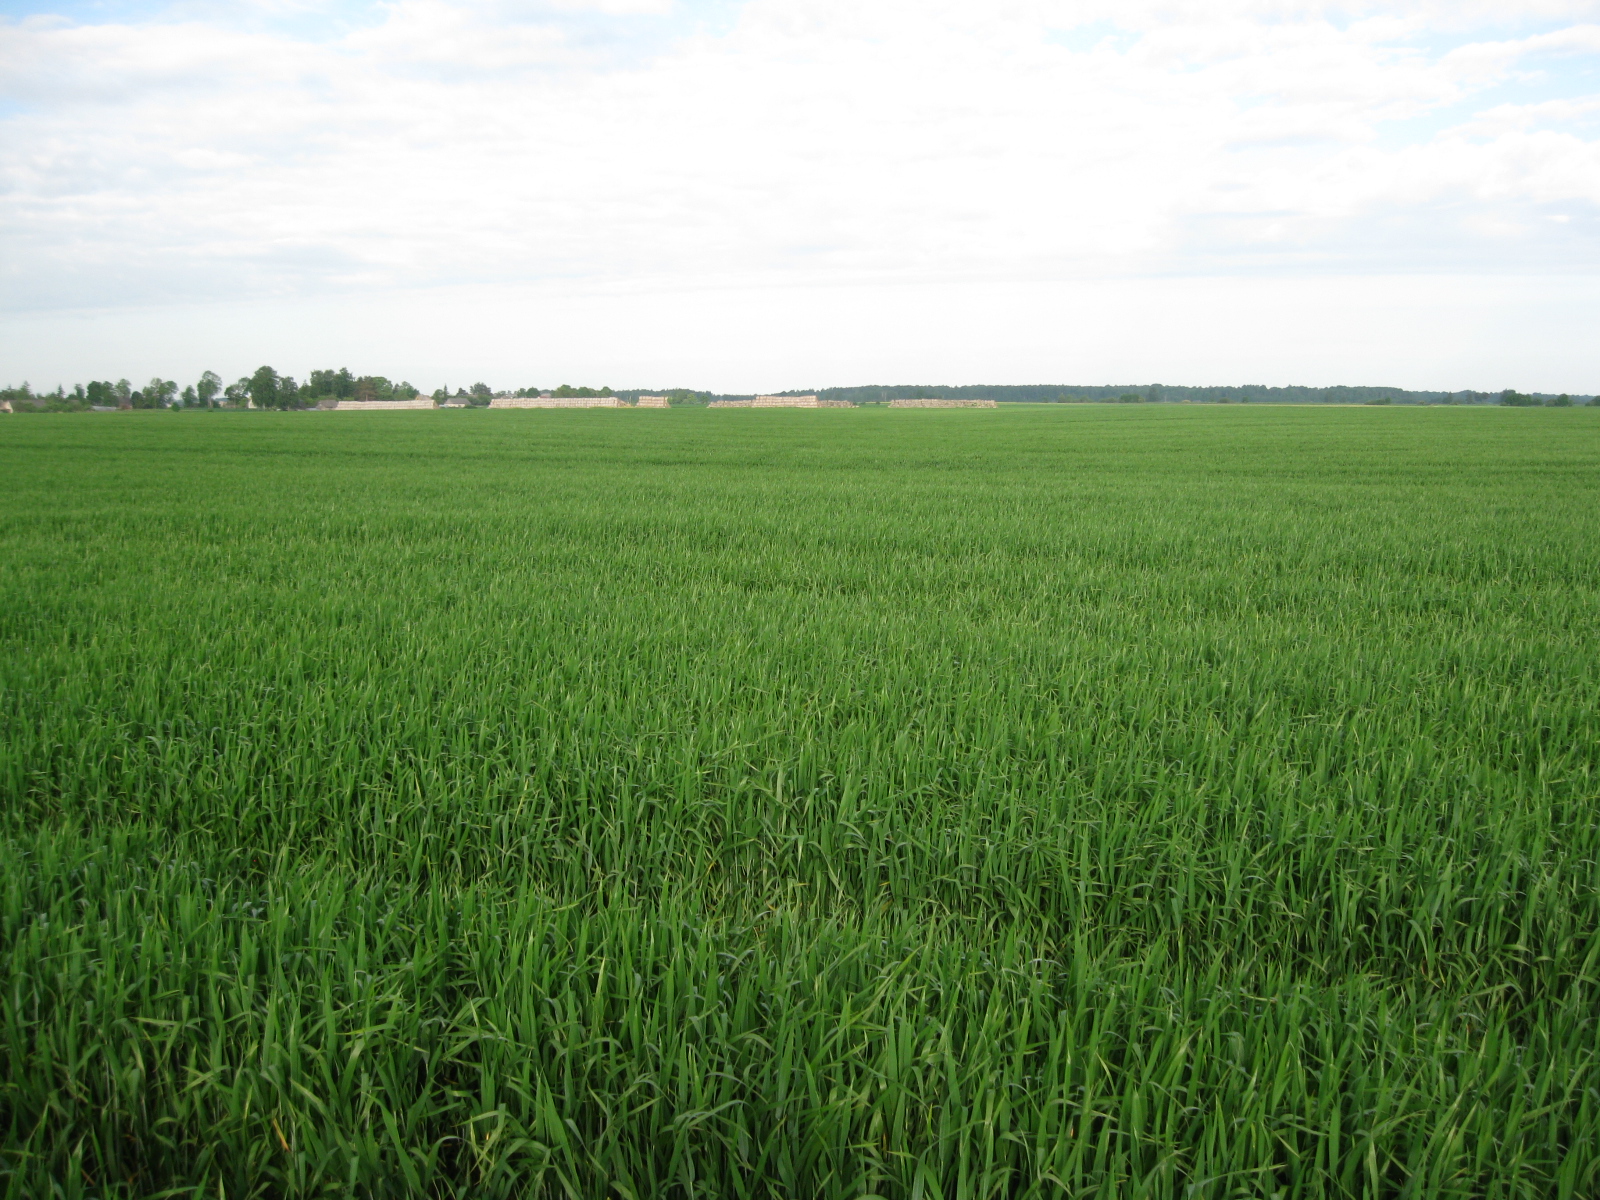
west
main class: Cropland
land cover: Common wheat
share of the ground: > 75 %
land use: Agriculture (excluding fallow land and kitchen gardens)
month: June
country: LT
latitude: 55.7095
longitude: 23.9822
